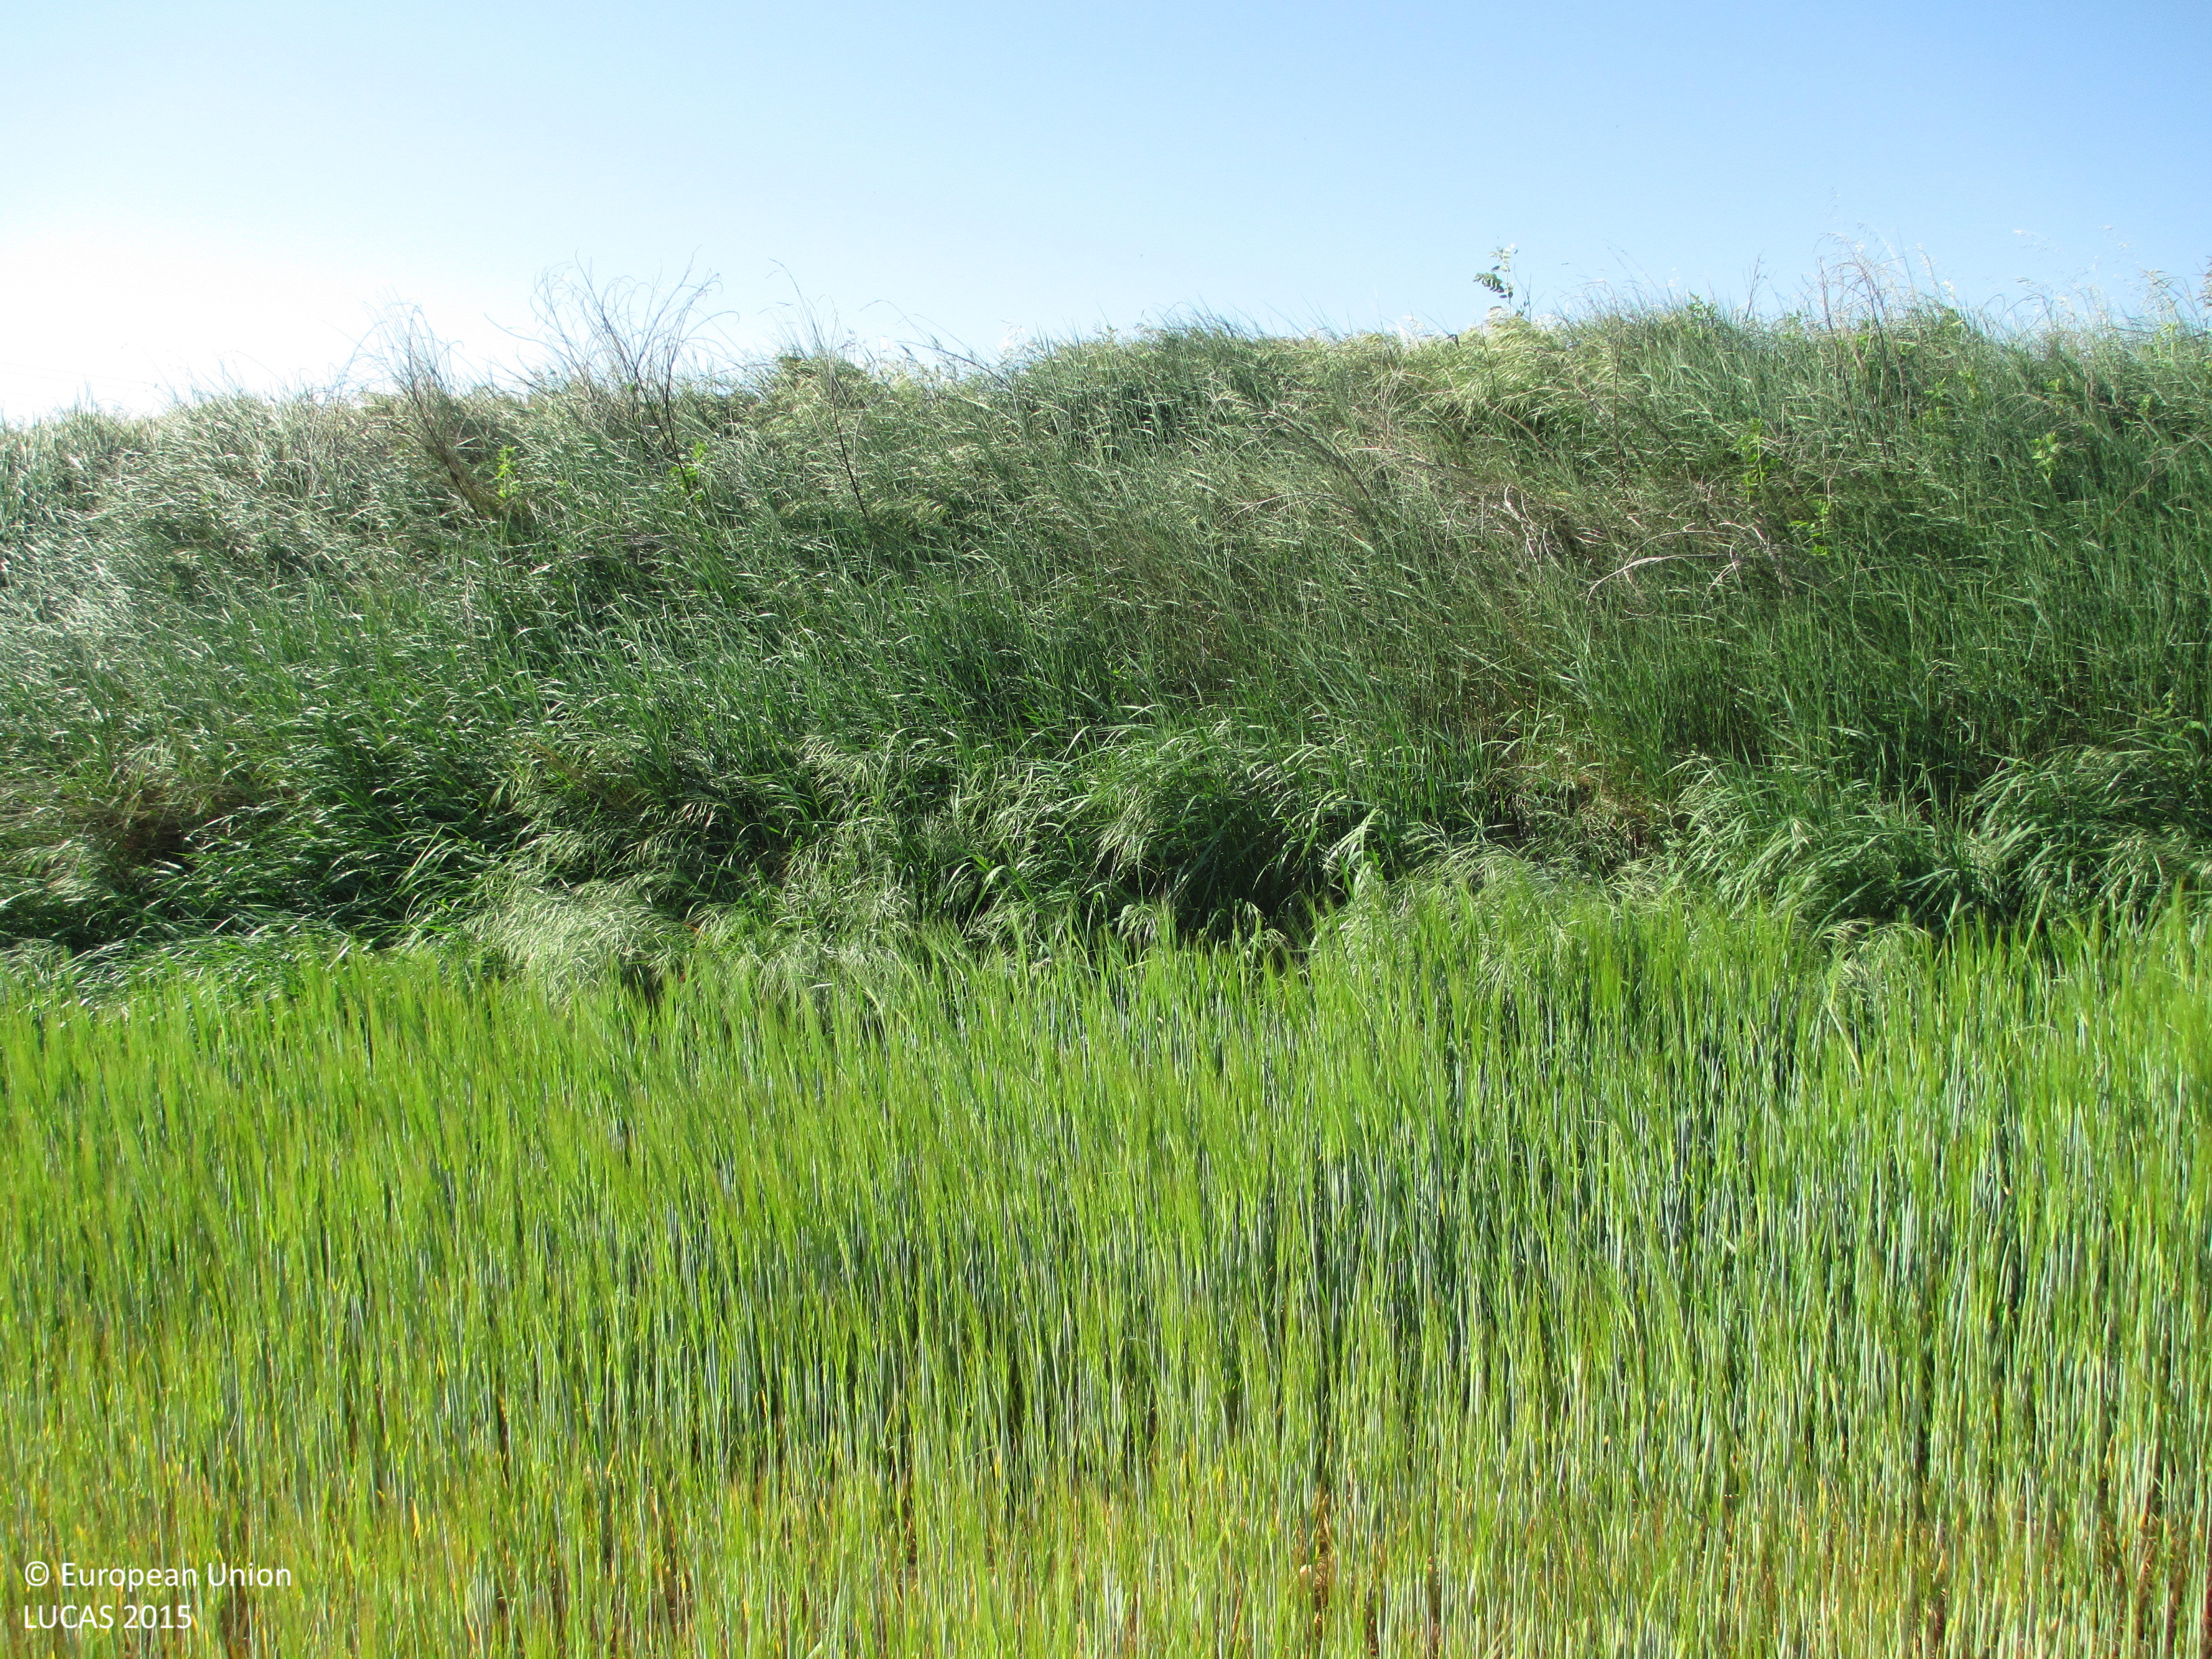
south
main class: Cropland
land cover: Barley
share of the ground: > 75 %
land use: Agriculture (excluding fallow land and kitchen gardens)
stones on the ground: < 10 %
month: May
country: ES
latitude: 41.9372
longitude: -0.3810
